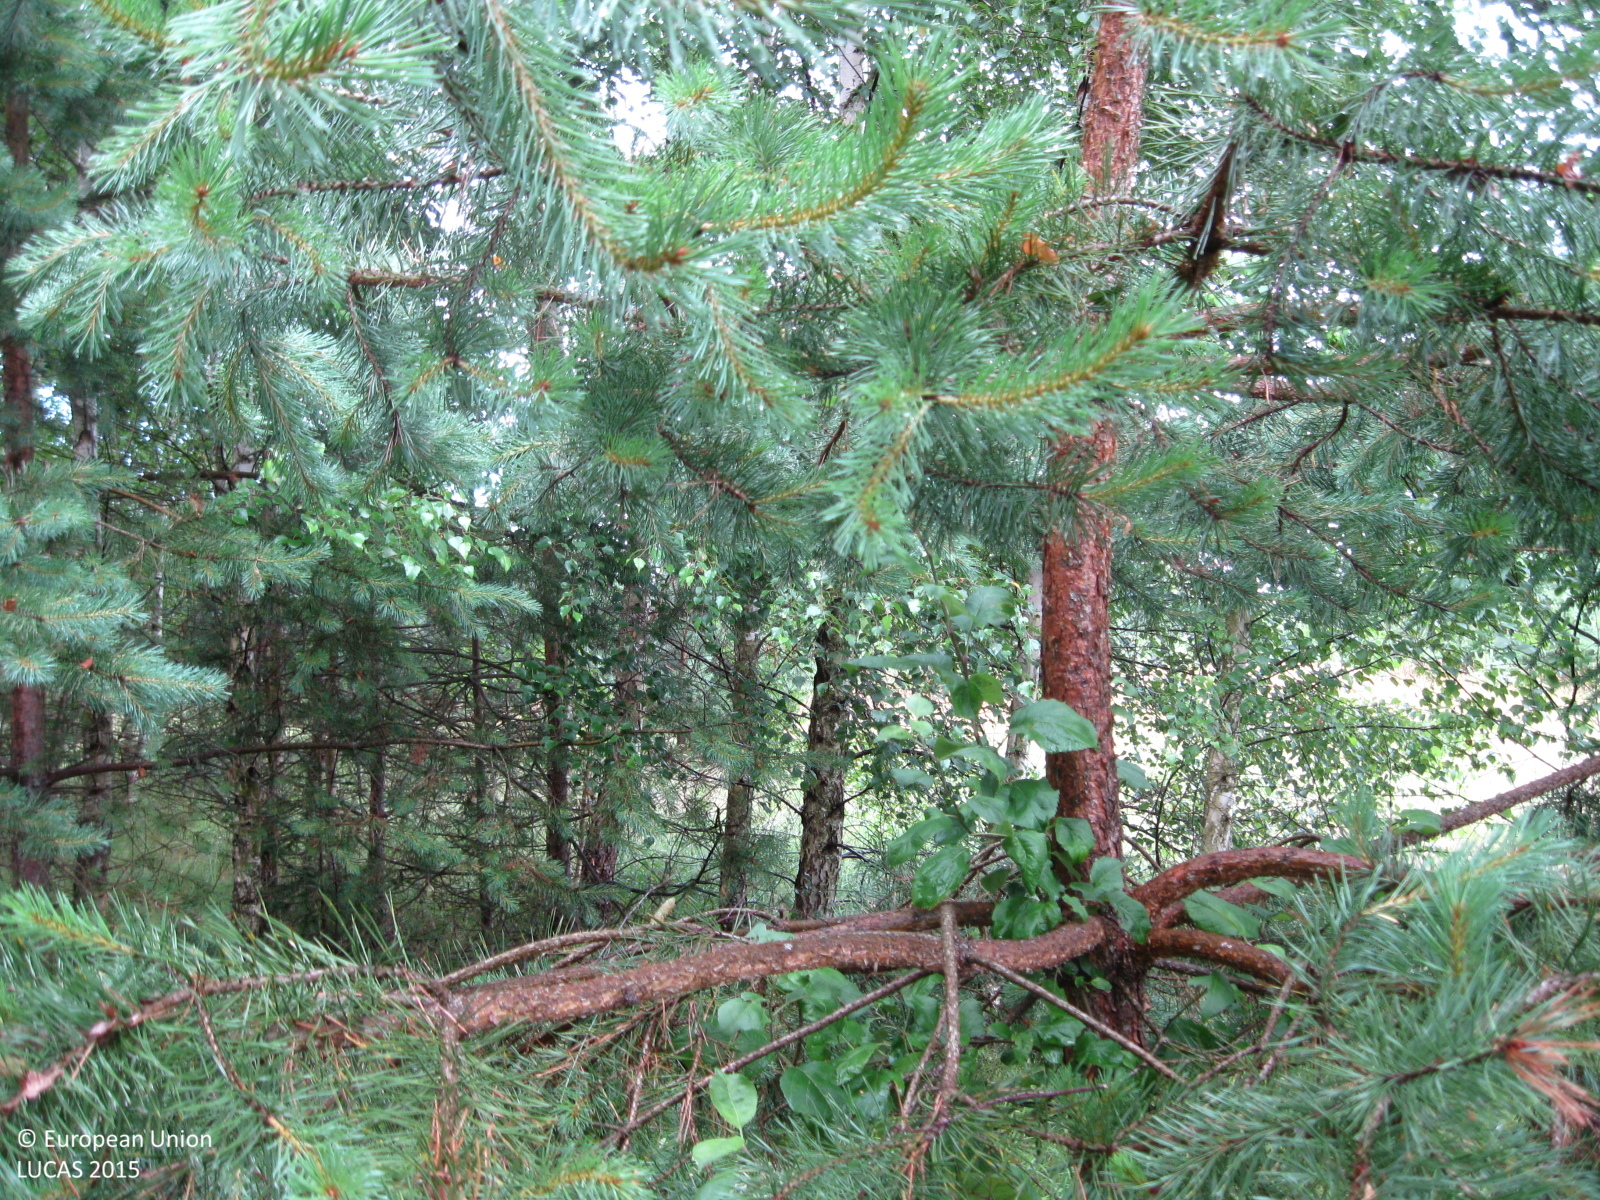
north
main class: Woodland
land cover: Pine dominated mixed woodland
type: hemiboreal forest and nemoral coniferous forest and mixed broadleaved-coniferous forest
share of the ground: 50 - 75 %
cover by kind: herbaceous plants 45 %, coniferous forest trees 35 %, broadleaved forest trees 20 %
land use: Forestry
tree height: > 5 m
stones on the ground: < 10 %
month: July
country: LT
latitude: 55.7503
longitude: 24.7463
